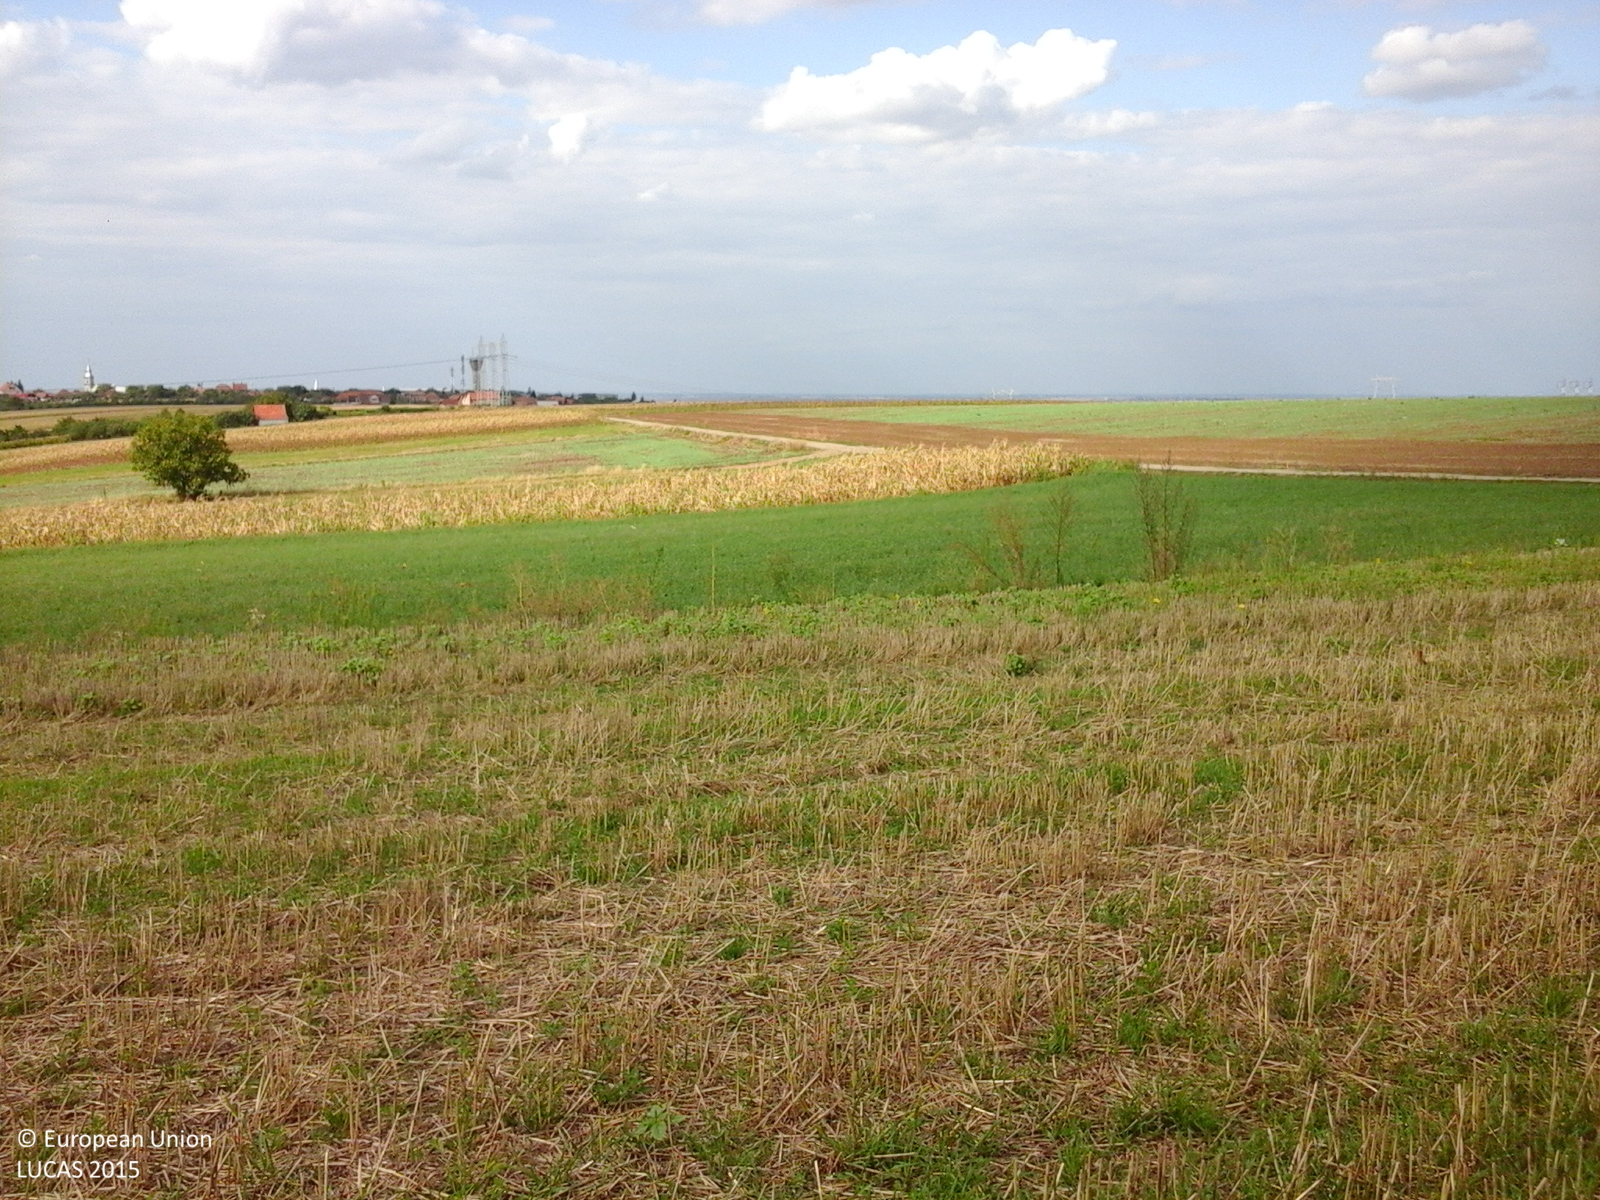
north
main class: Cropland
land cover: Common wheat
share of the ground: 50 - 75 %
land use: Agriculture (excluding fallow land and kitchen gardens)
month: September
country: RO
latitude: 47.4614
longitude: 22.5942
